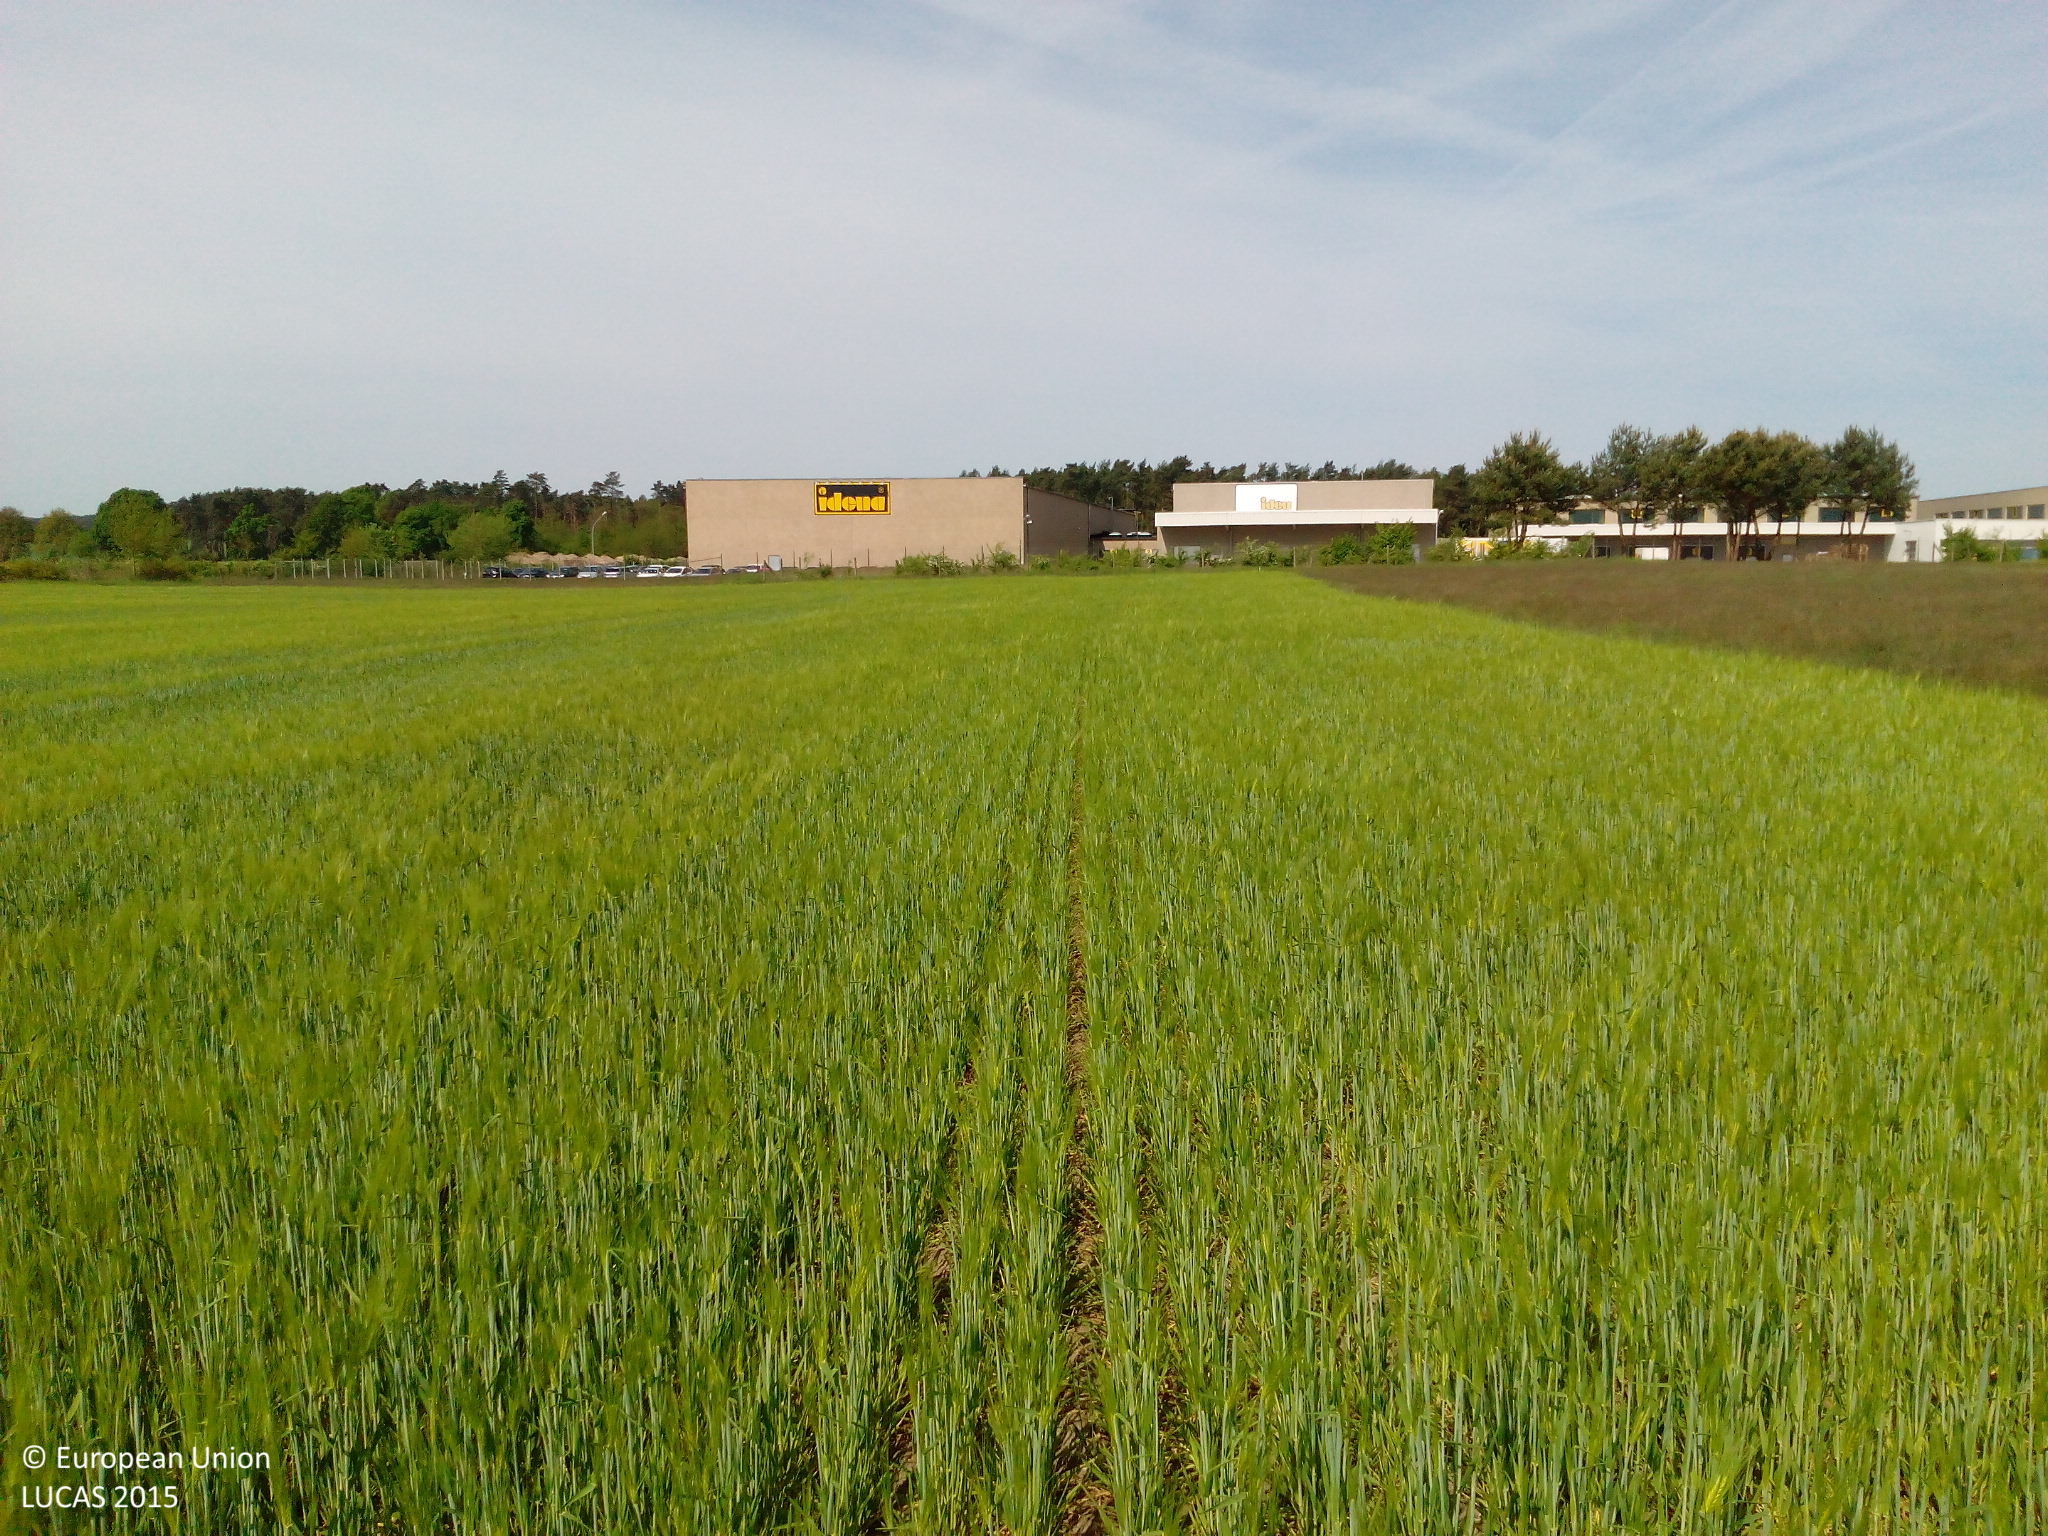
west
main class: Cropland
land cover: Barley
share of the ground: > 75 %
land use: Agriculture (excluding fallow land and kitchen gardens)
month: May
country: DE
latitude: 51.9821
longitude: 13.5676
